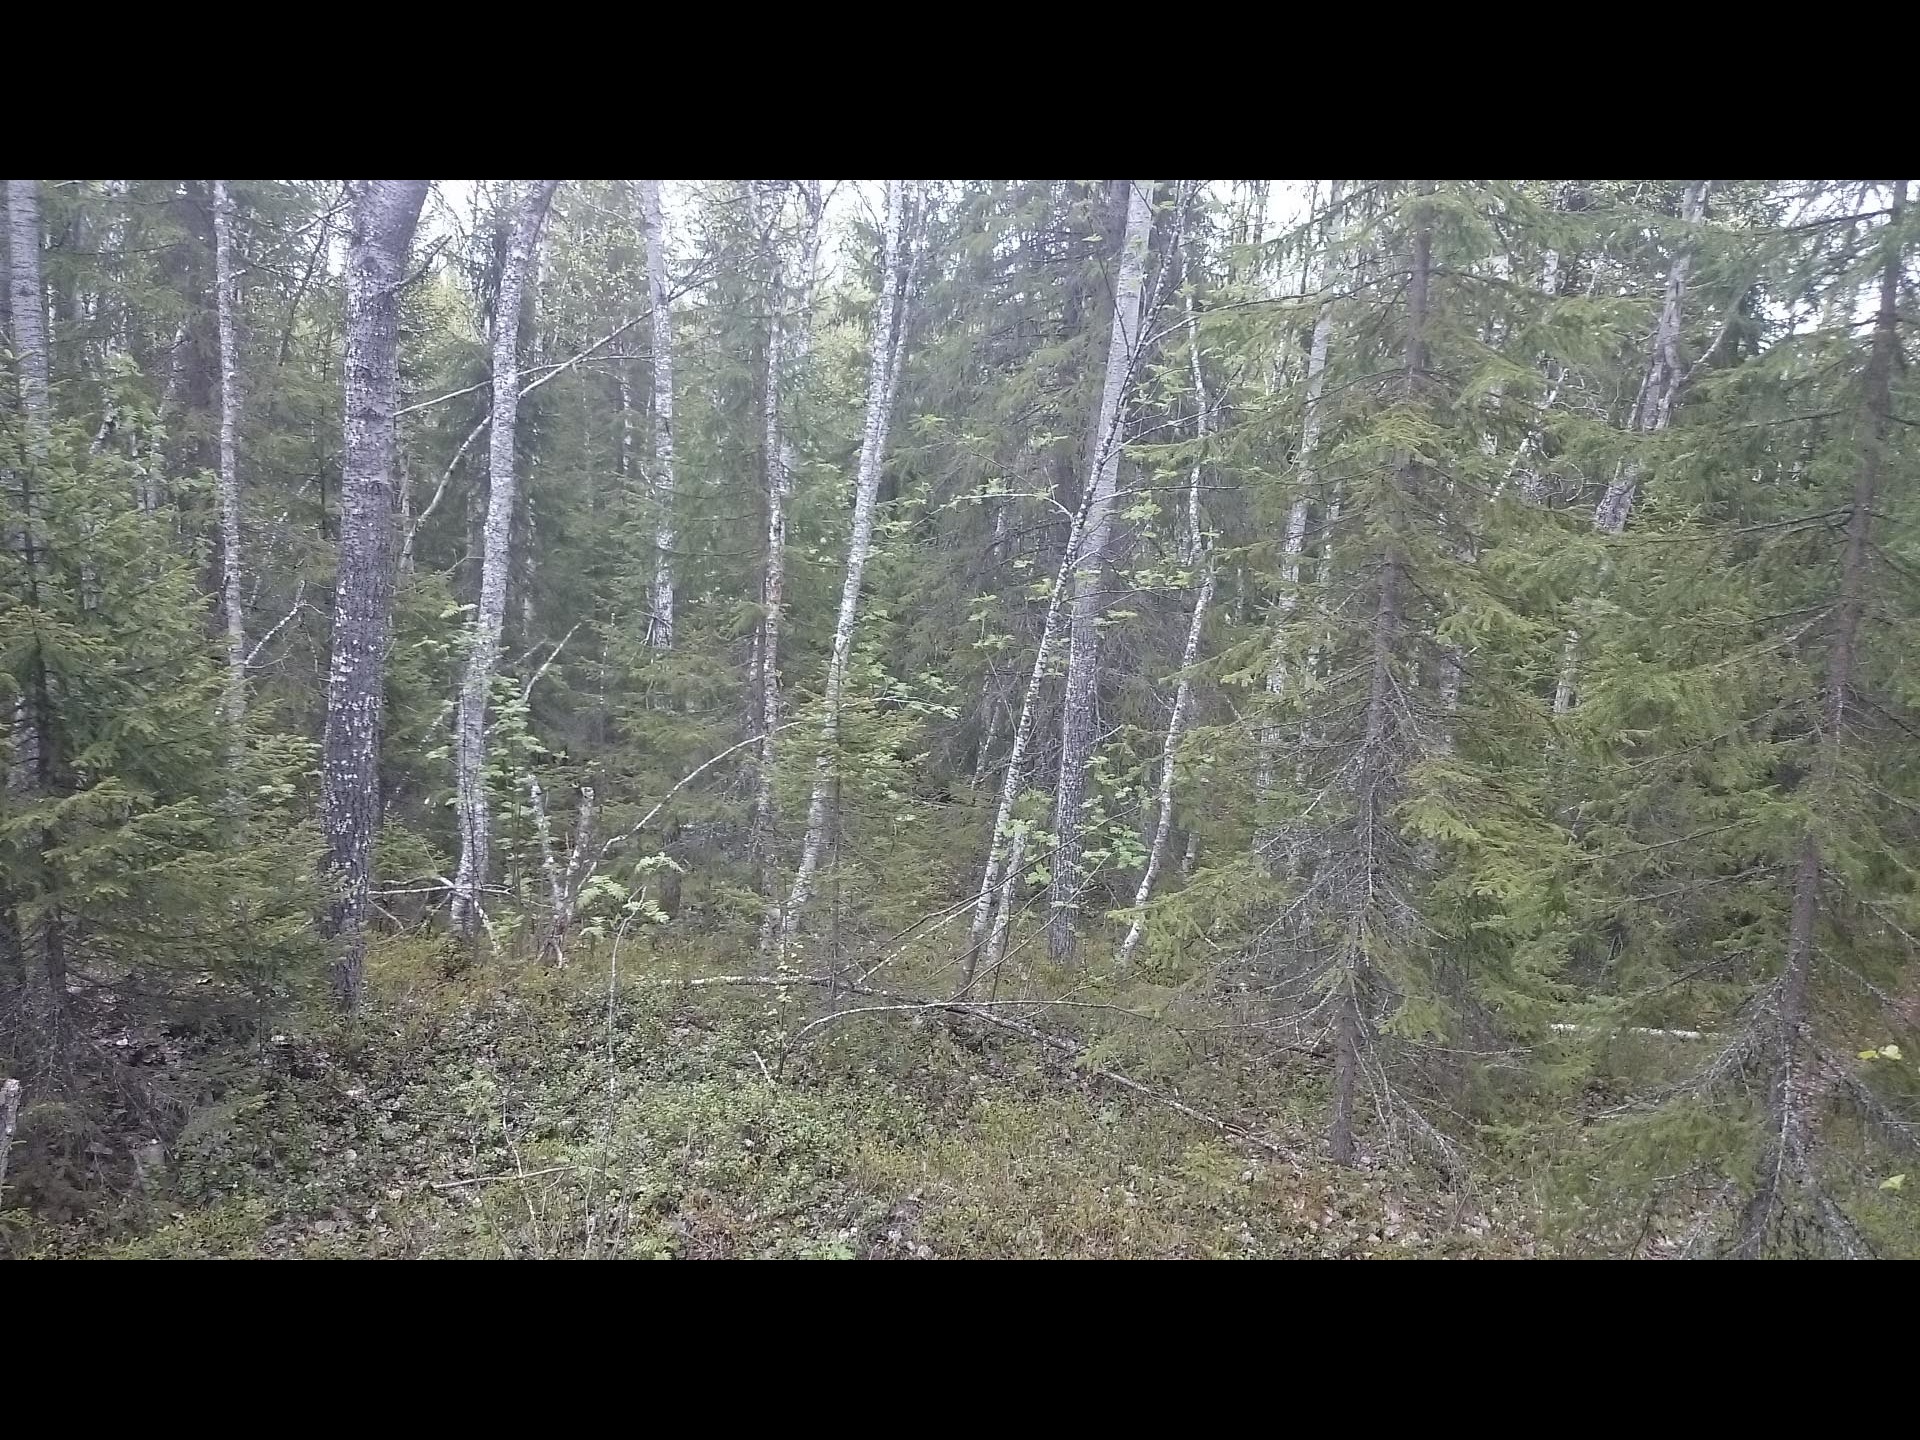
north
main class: Woodland
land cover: Spruce dominated mixed woodland
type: boreal forest
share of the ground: > 75 %
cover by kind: coniferous forest trees 60 %, broadleaved forest trees 20 %, shrubs 15 %, herbaceous plants 5 %
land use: Forestry
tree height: > 5 m
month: June
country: SE
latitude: 63.6469
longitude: 13.8363
